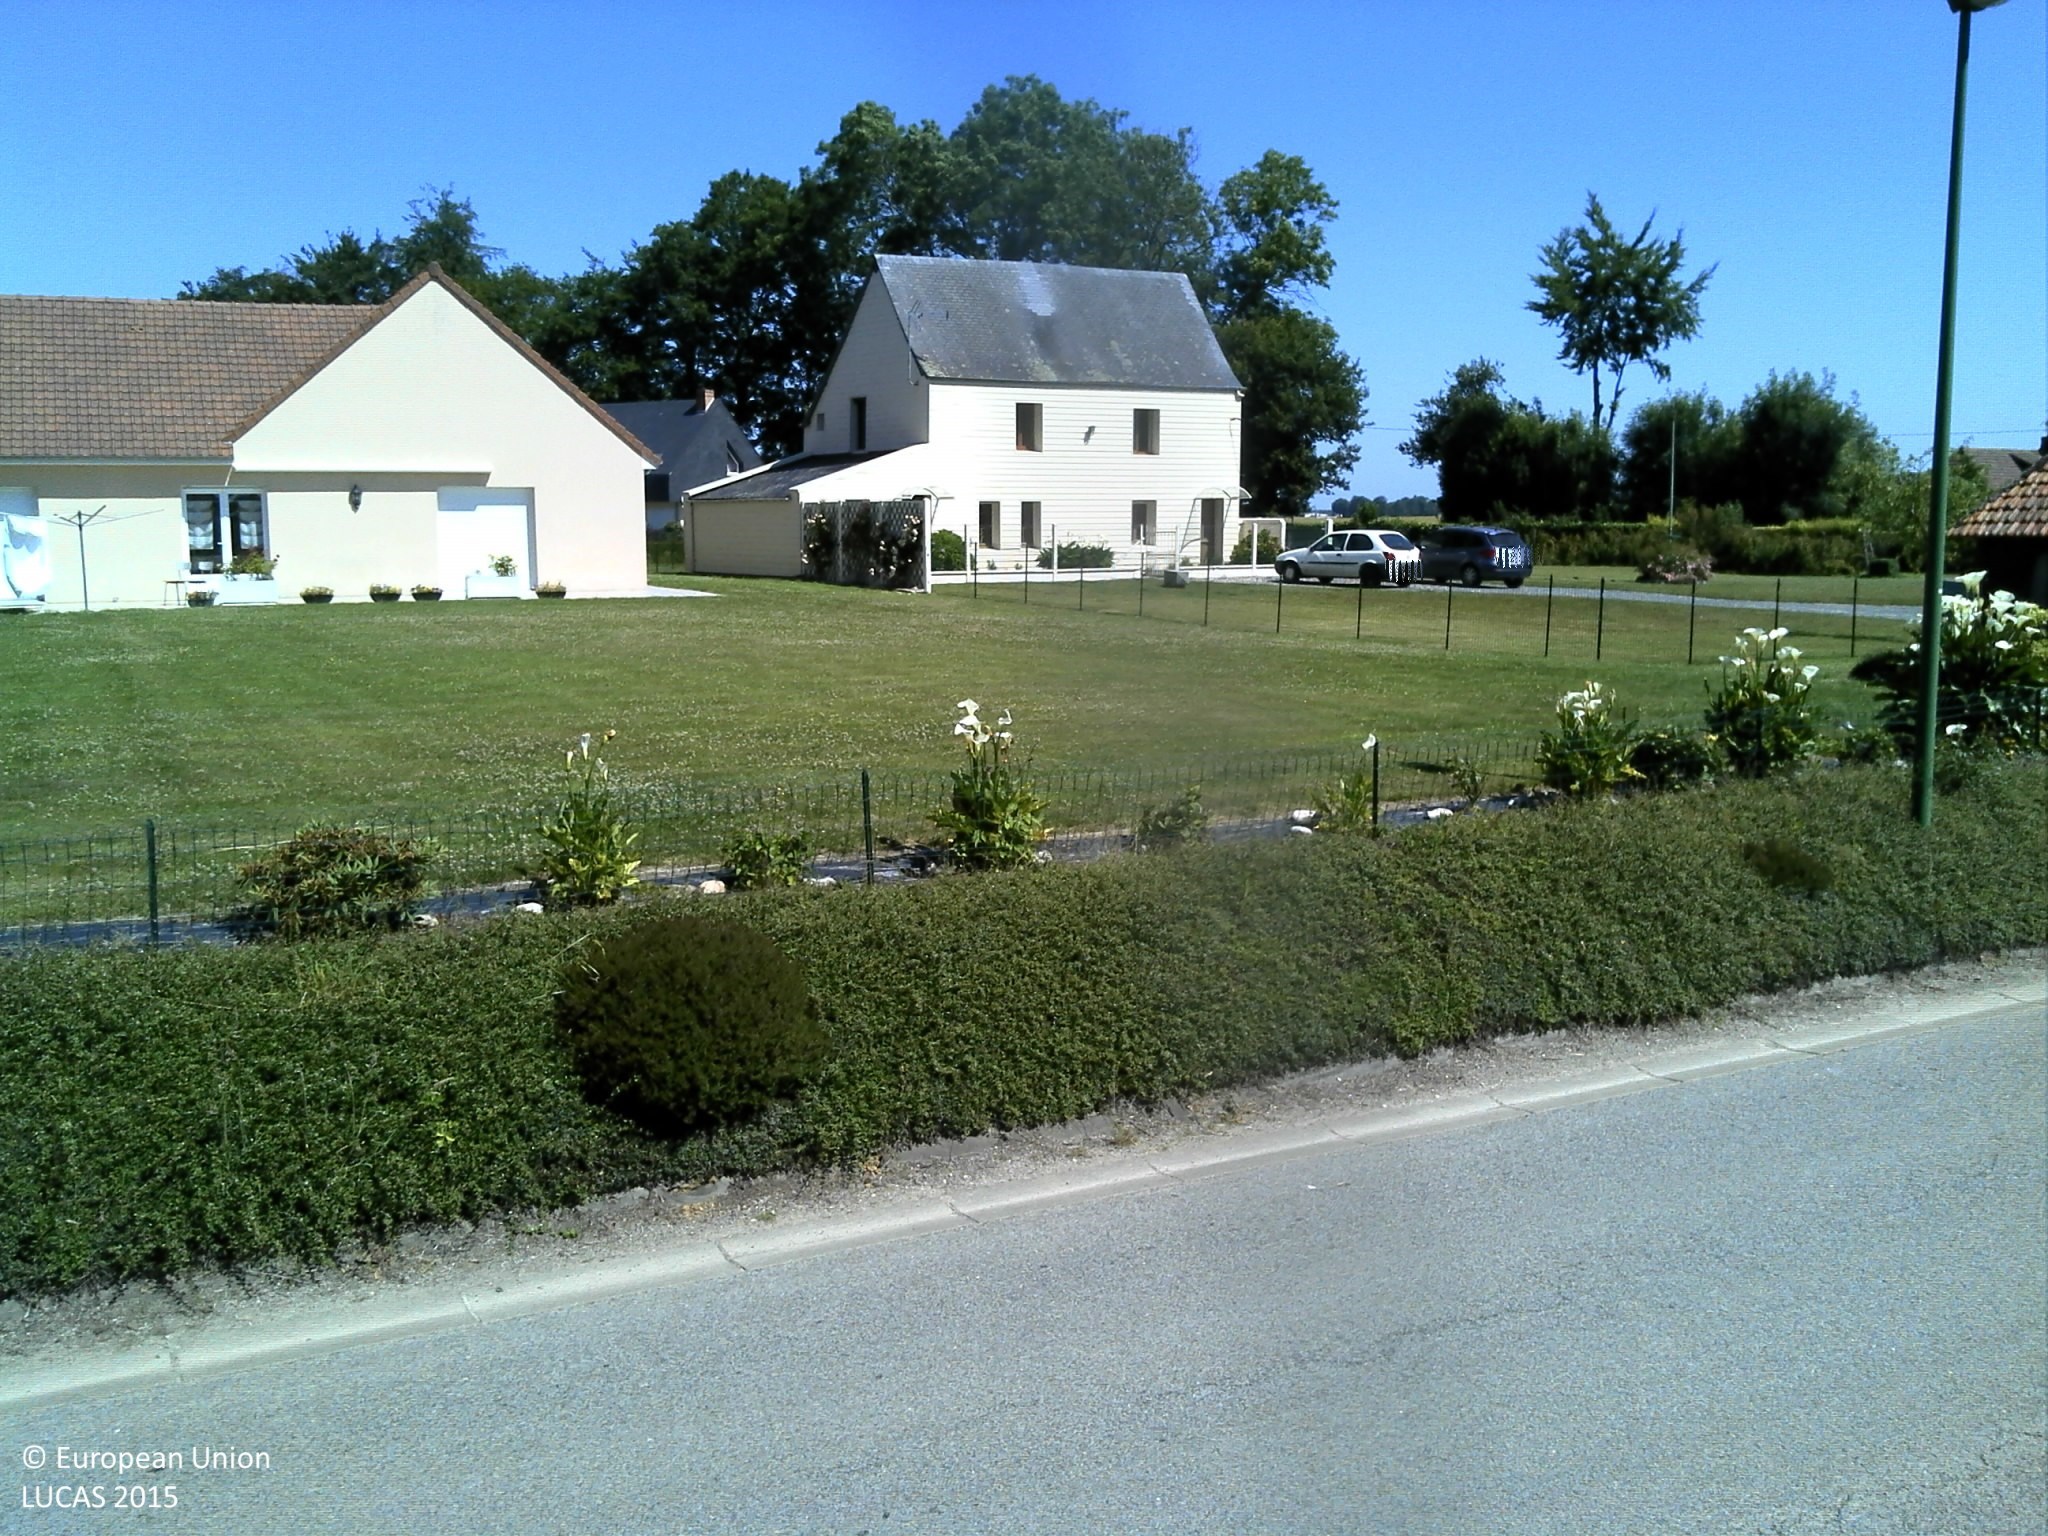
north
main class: Grassland
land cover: Grassland with sparse tree/shrub cover
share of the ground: > 75 %
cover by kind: herbaceous plants 95 %, broadleaved forest trees 5 %
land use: Agriculture (excluding fallow land and kitchen gardens)
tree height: < 5 m
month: June
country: FR
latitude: 49.8308
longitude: 1.0385
